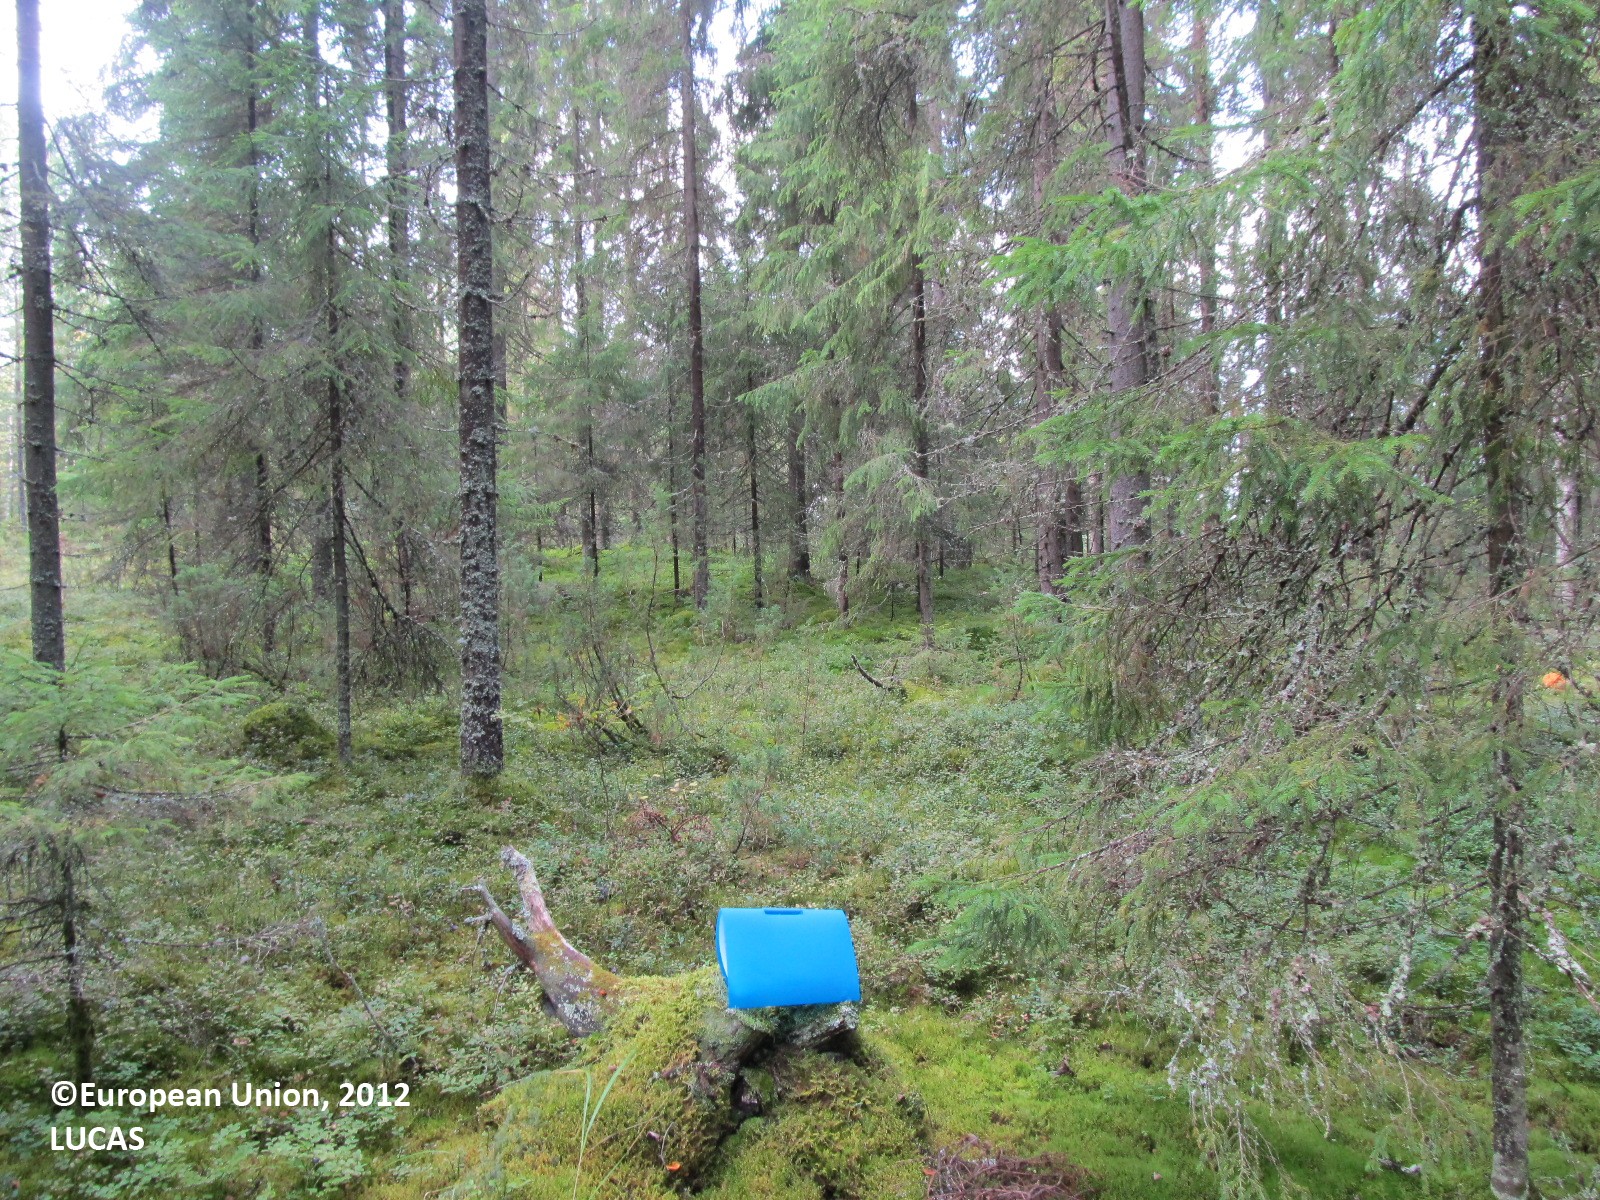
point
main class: Woodland
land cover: Spruce dominated coniferous woodland
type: boreal forest
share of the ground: 50 - 75 %
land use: Forestry
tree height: > 5 m
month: September
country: FI
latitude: 62.9097
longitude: 28.4404
